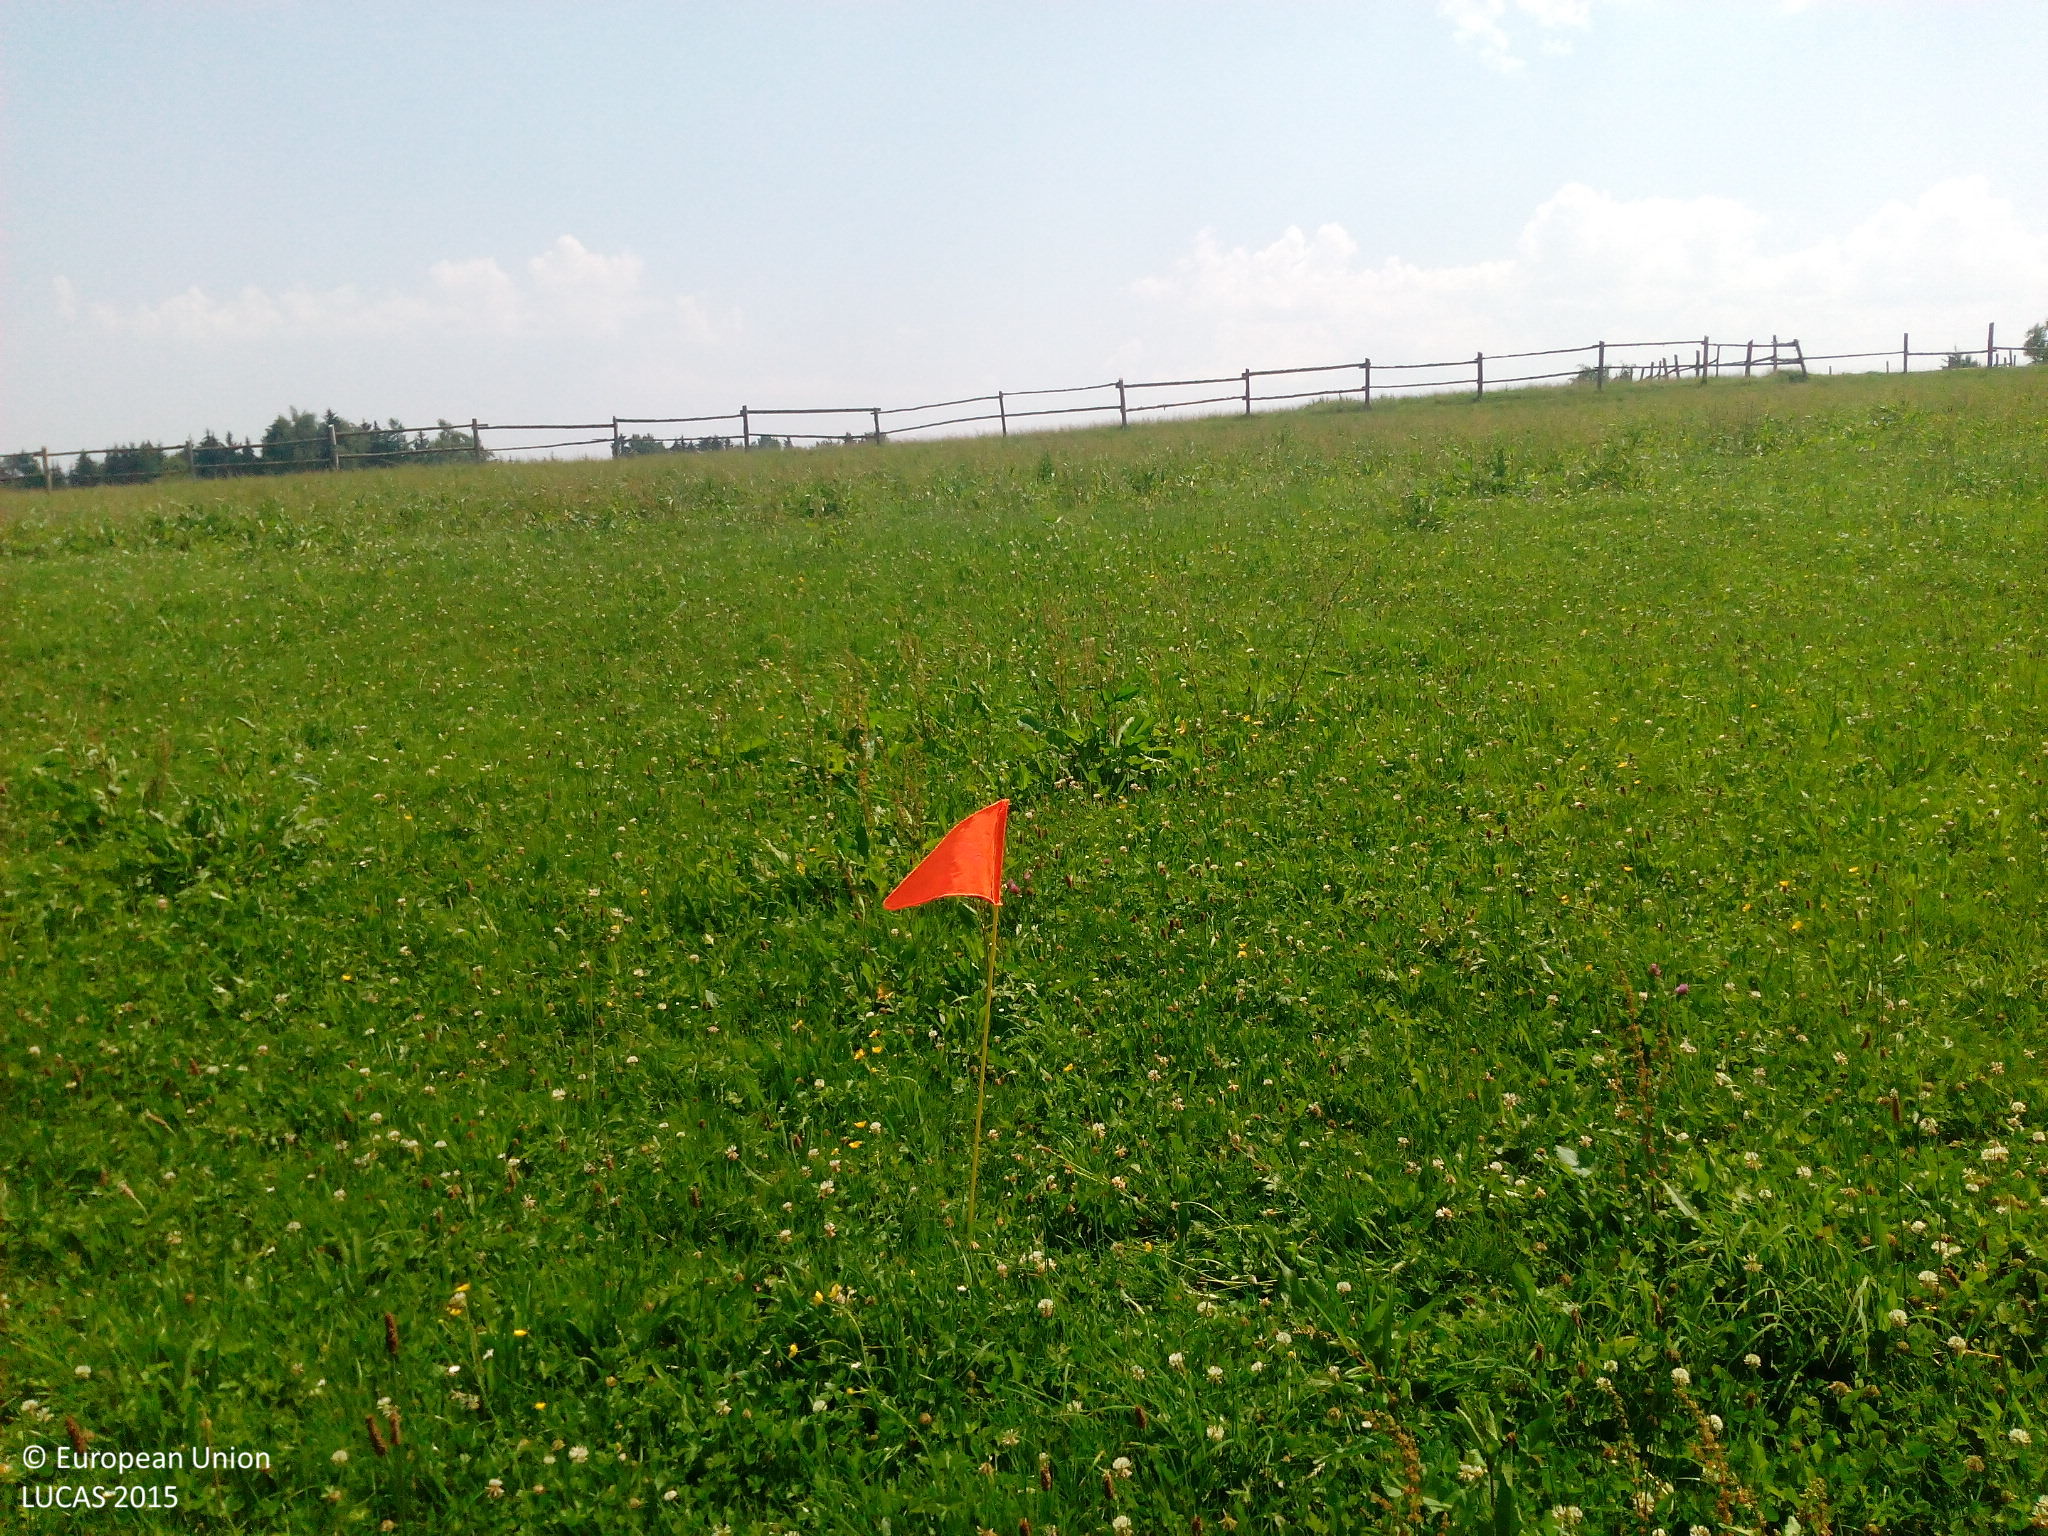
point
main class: Grassland
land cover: Grassland without tree/shrub cover
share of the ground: > 75 %
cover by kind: herbaceous plants 100 %
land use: Agriculture (excluding fallow land and kitchen gardens)
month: July
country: DE
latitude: 47.8615
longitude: 9.3188
